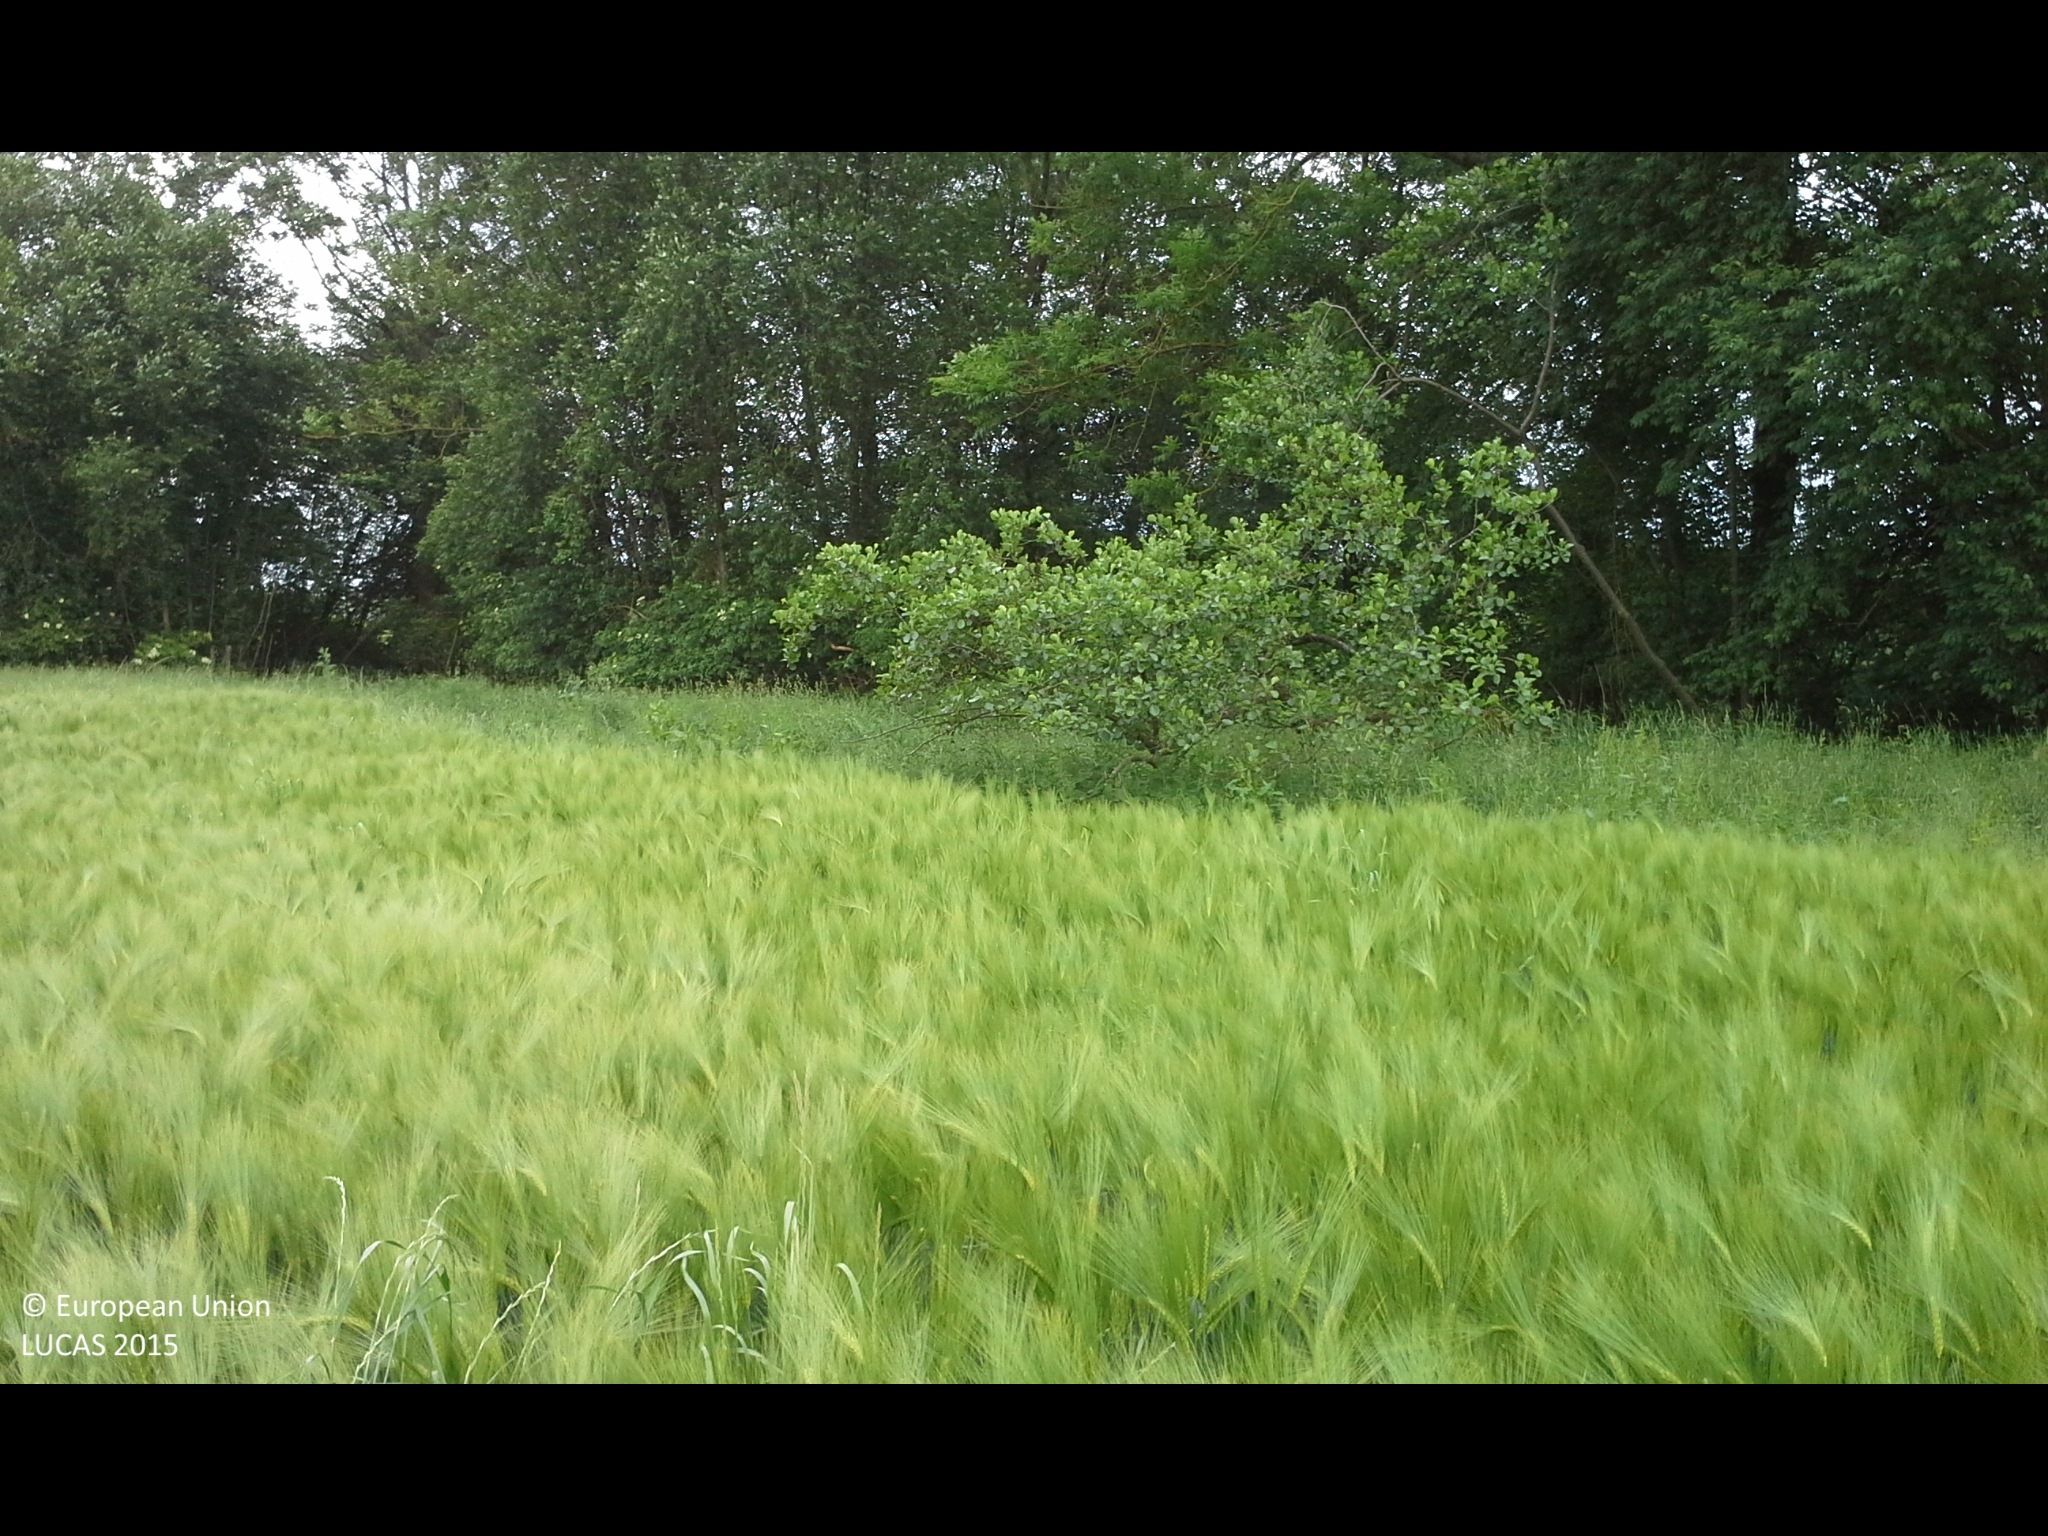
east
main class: Cropland
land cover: Barley
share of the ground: > 75 %
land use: Agriculture (excluding fallow land and kitchen gardens)
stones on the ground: < 10 %
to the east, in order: Barley; Grassland without tree/shrub cover; Broadleaved woodland; Rivers and streams; Broadleaved woodland; Grass margins; Common wheat; Electric lines; Common wheat; Tracks; Soya
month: May
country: AT
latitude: 48.2067
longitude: 14.4273
